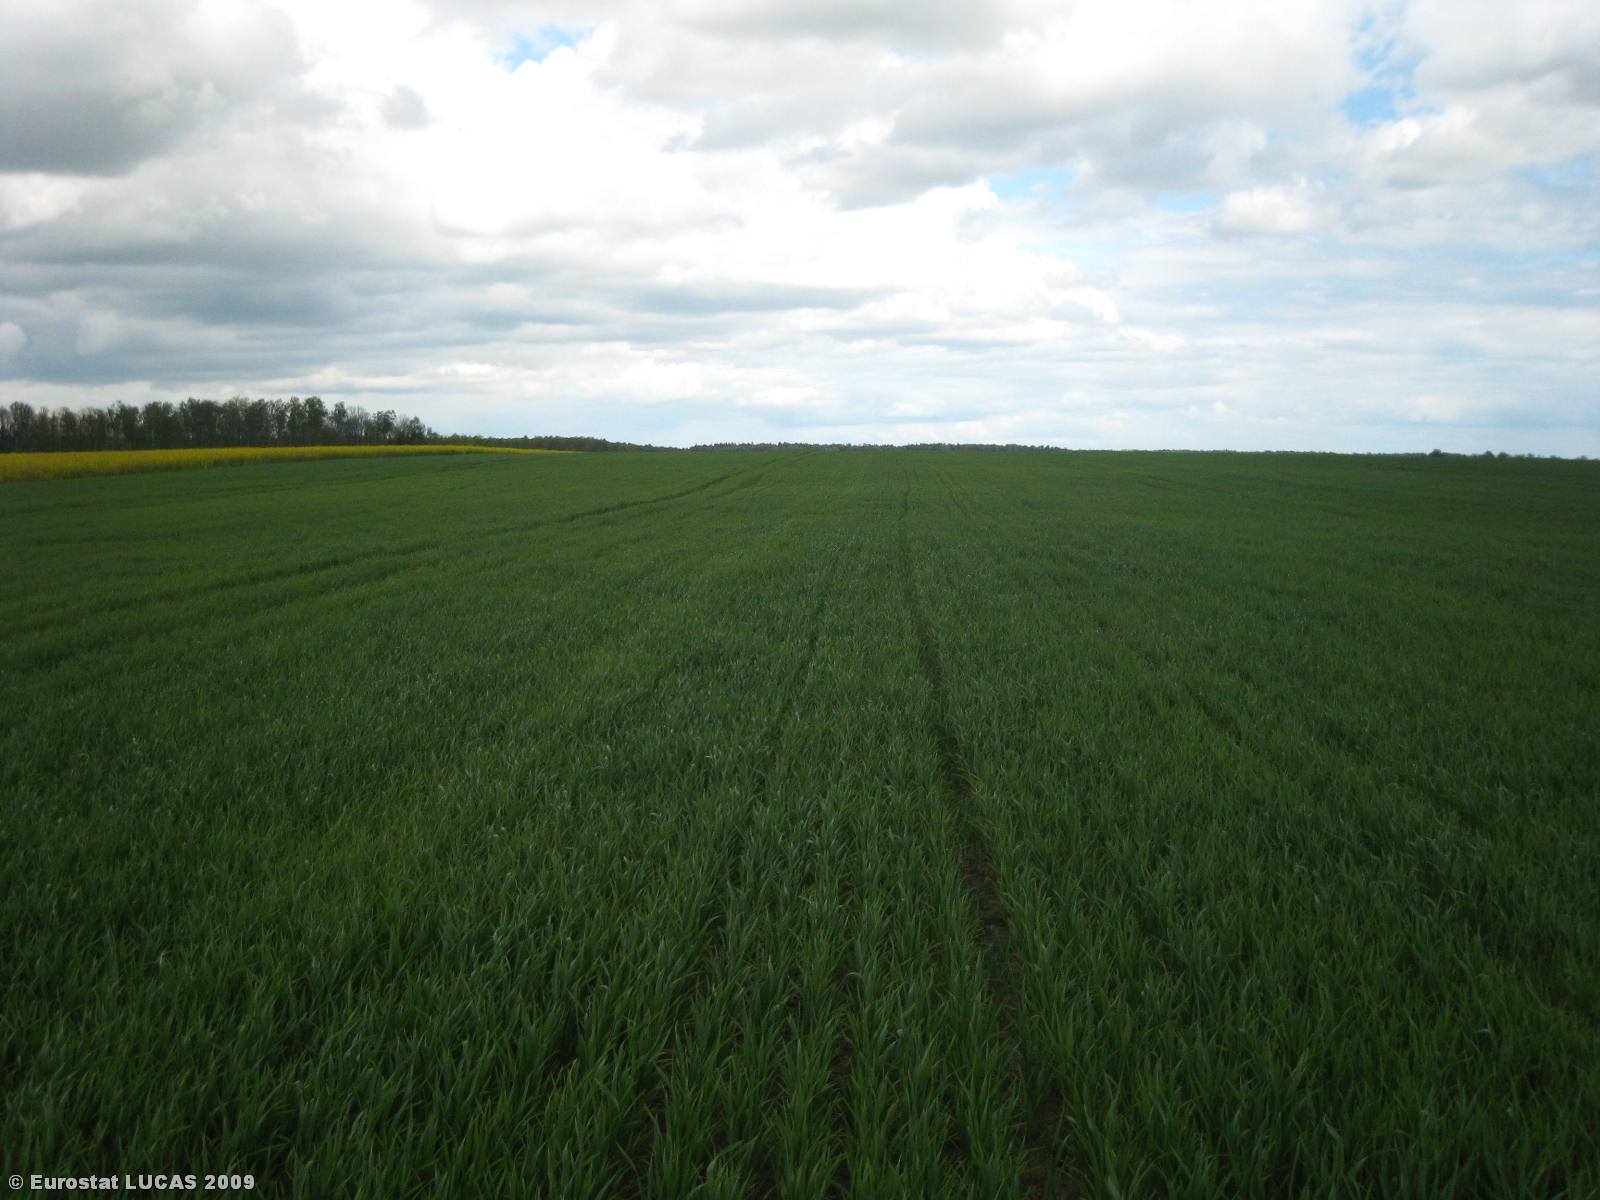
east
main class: Cropland
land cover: Common wheat
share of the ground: > 75 %
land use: Agriculture (excluding fallow land and kitchen gardens)
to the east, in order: Common wheat
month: May
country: LT
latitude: 56.0117
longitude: 24.0590
